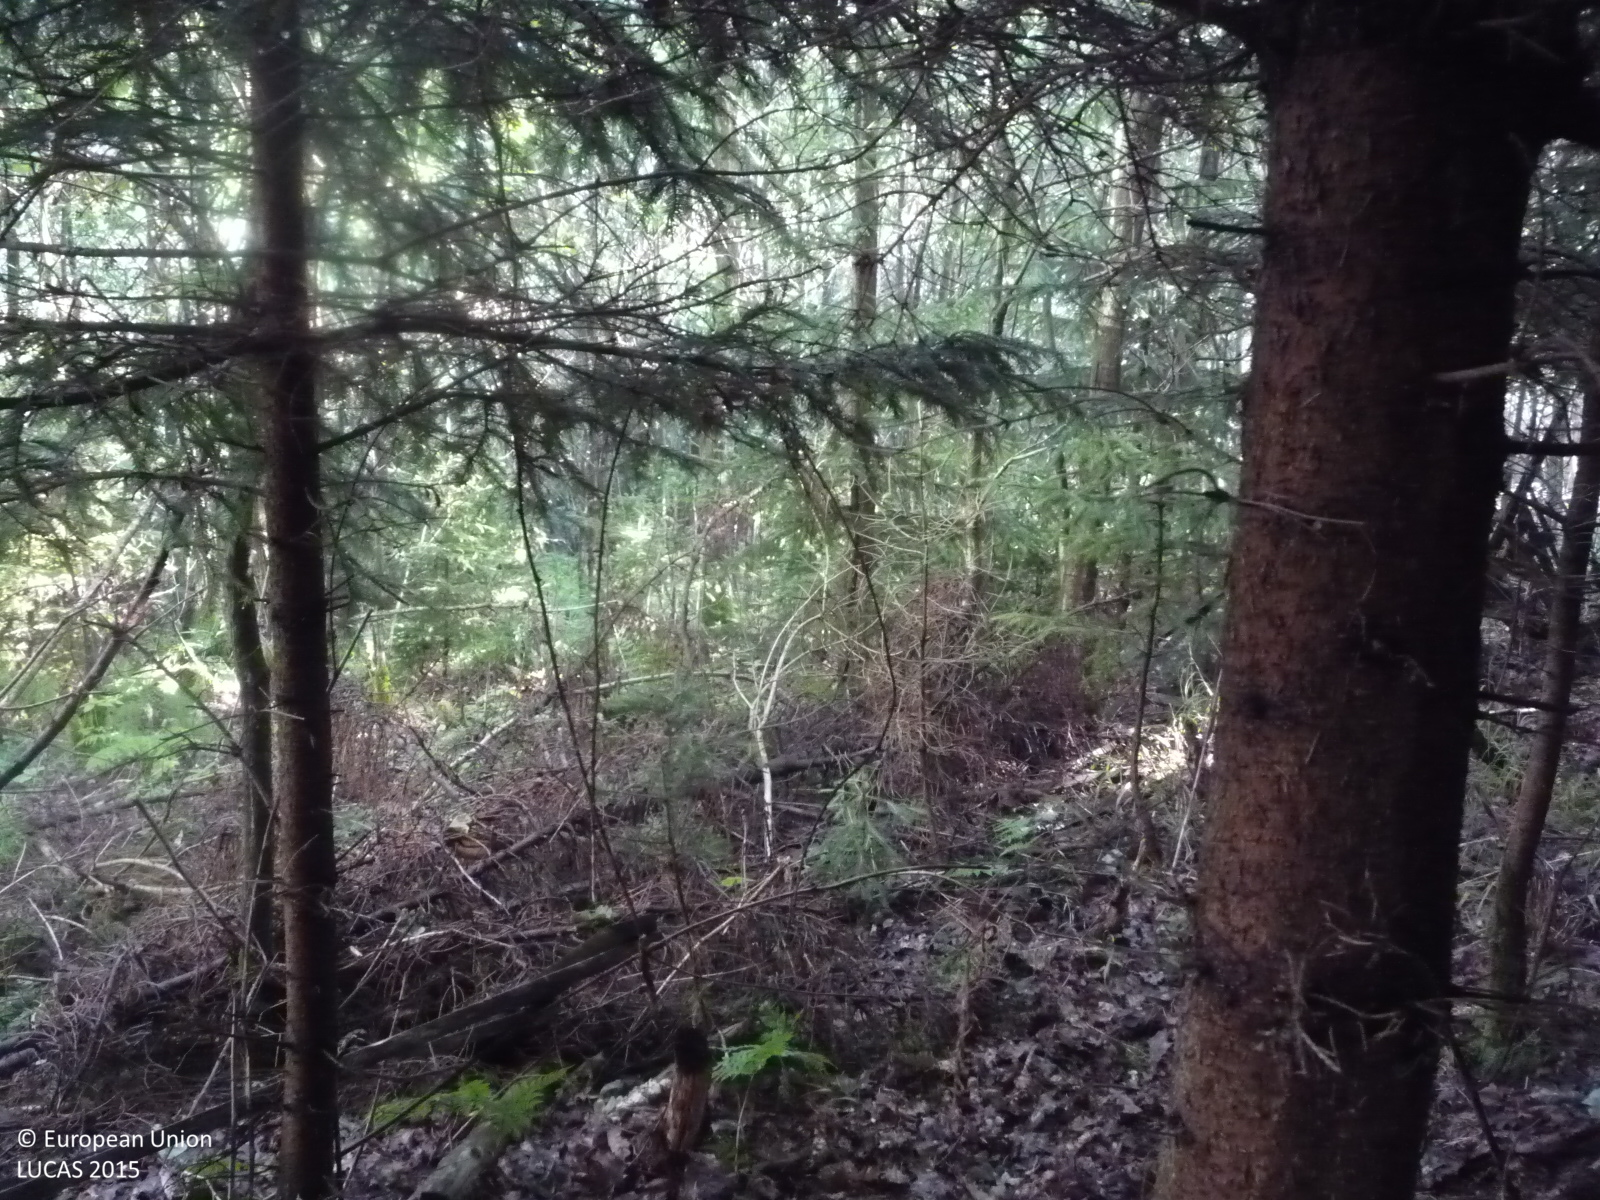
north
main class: Woodland
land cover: Spruce dominated coniferous woodland
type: hemiboreal forest and nemoral coniferous forest and mixed broadleaved-coniferous forest
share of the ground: > 75 %
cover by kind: coniferous forest trees 85 %, herbaceous plants 15 %
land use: Forestry
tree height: > 5 m
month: July
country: CZ
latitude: 50.5298
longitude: 15.2938
